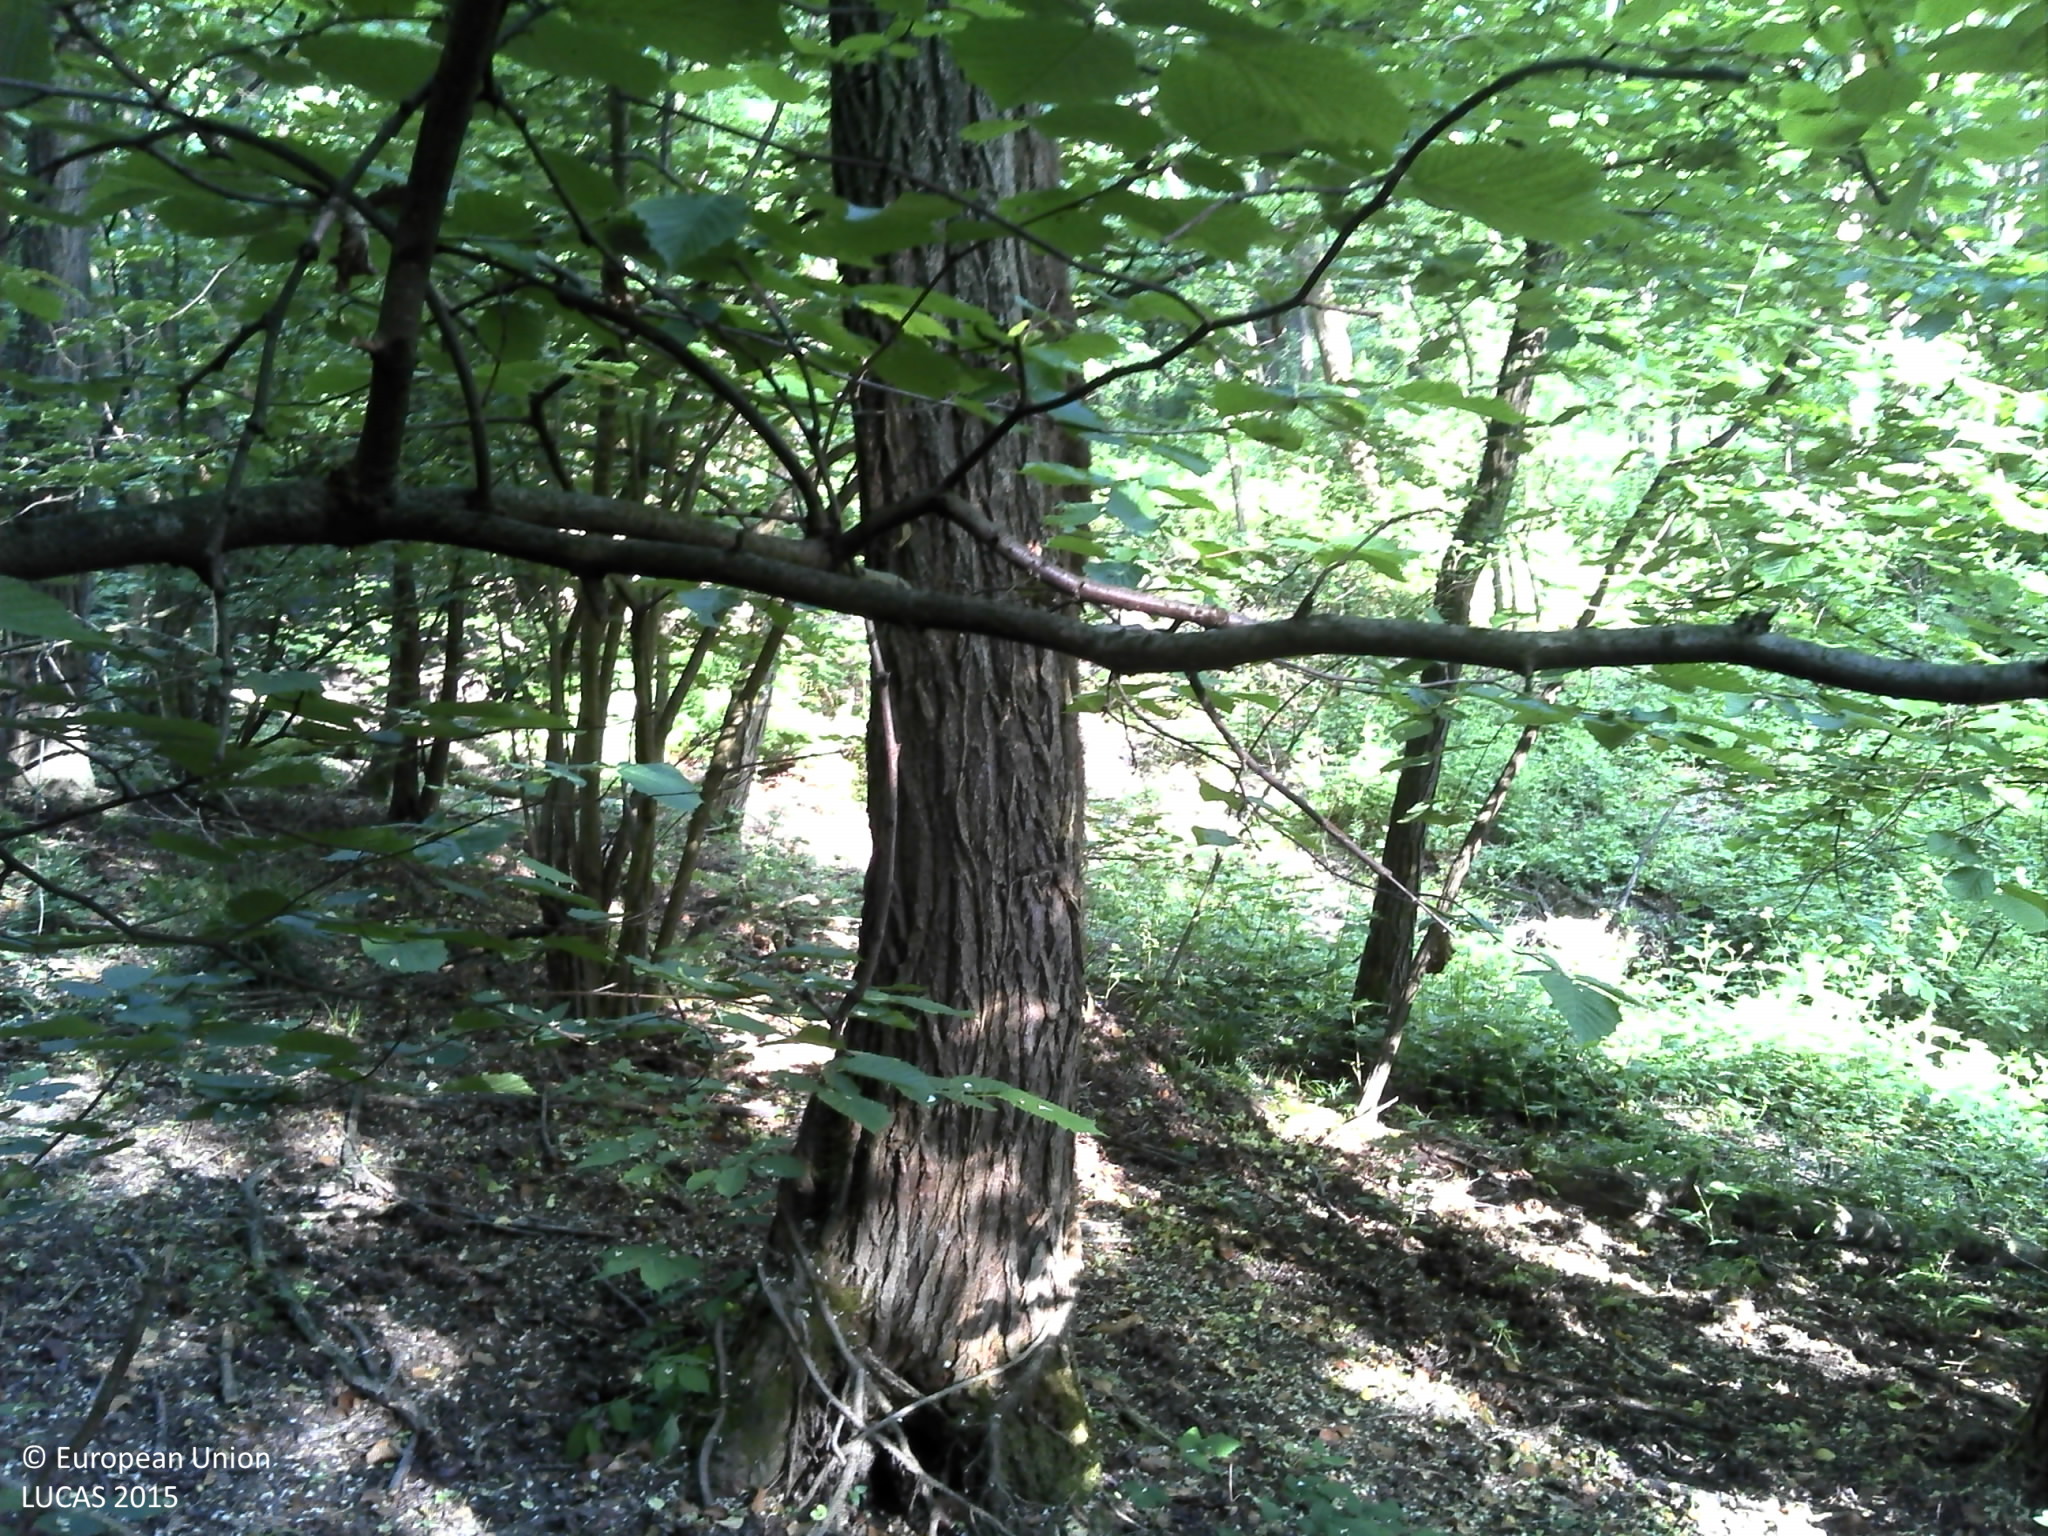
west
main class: Woodland
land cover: Broadleaved woodland
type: mesophytic deciduous forest
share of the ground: > 75 %
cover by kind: broadleaved forest trees 100 %
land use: Forestry
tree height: > 5 m
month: May
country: HR
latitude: 45.4939
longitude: 17.9500
